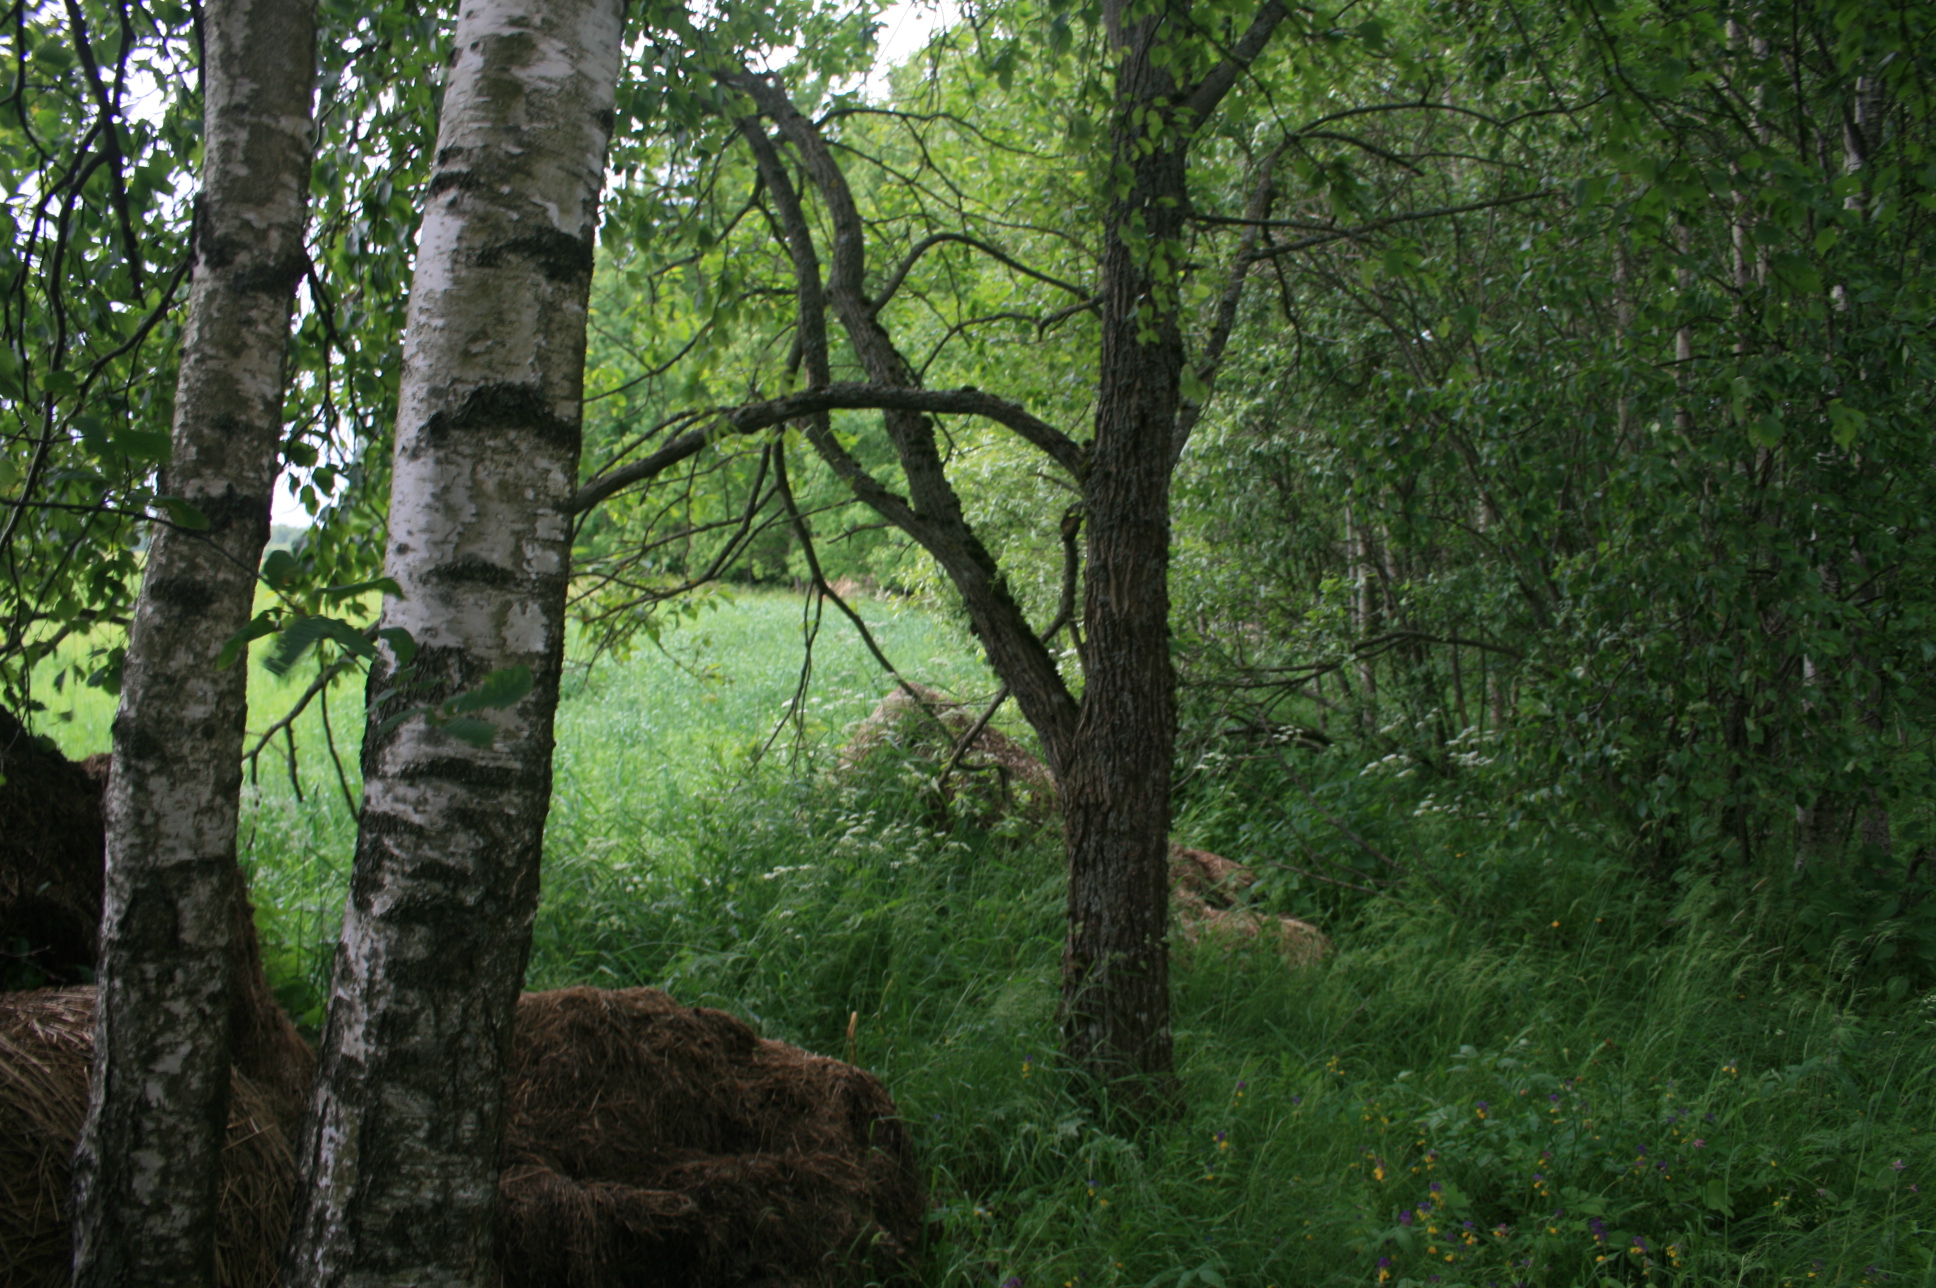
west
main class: Woodland
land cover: Broadleaved woodland
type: non-riverine alder, birch or aspen forest
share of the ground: > 75 %
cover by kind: broadleaved forest trees 80 %, shrubs 10 %, herbaceous plants 10 %
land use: Forestry
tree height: > 5 m
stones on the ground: < 10 %
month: June
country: LT
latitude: 55.6409
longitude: 22.3713
